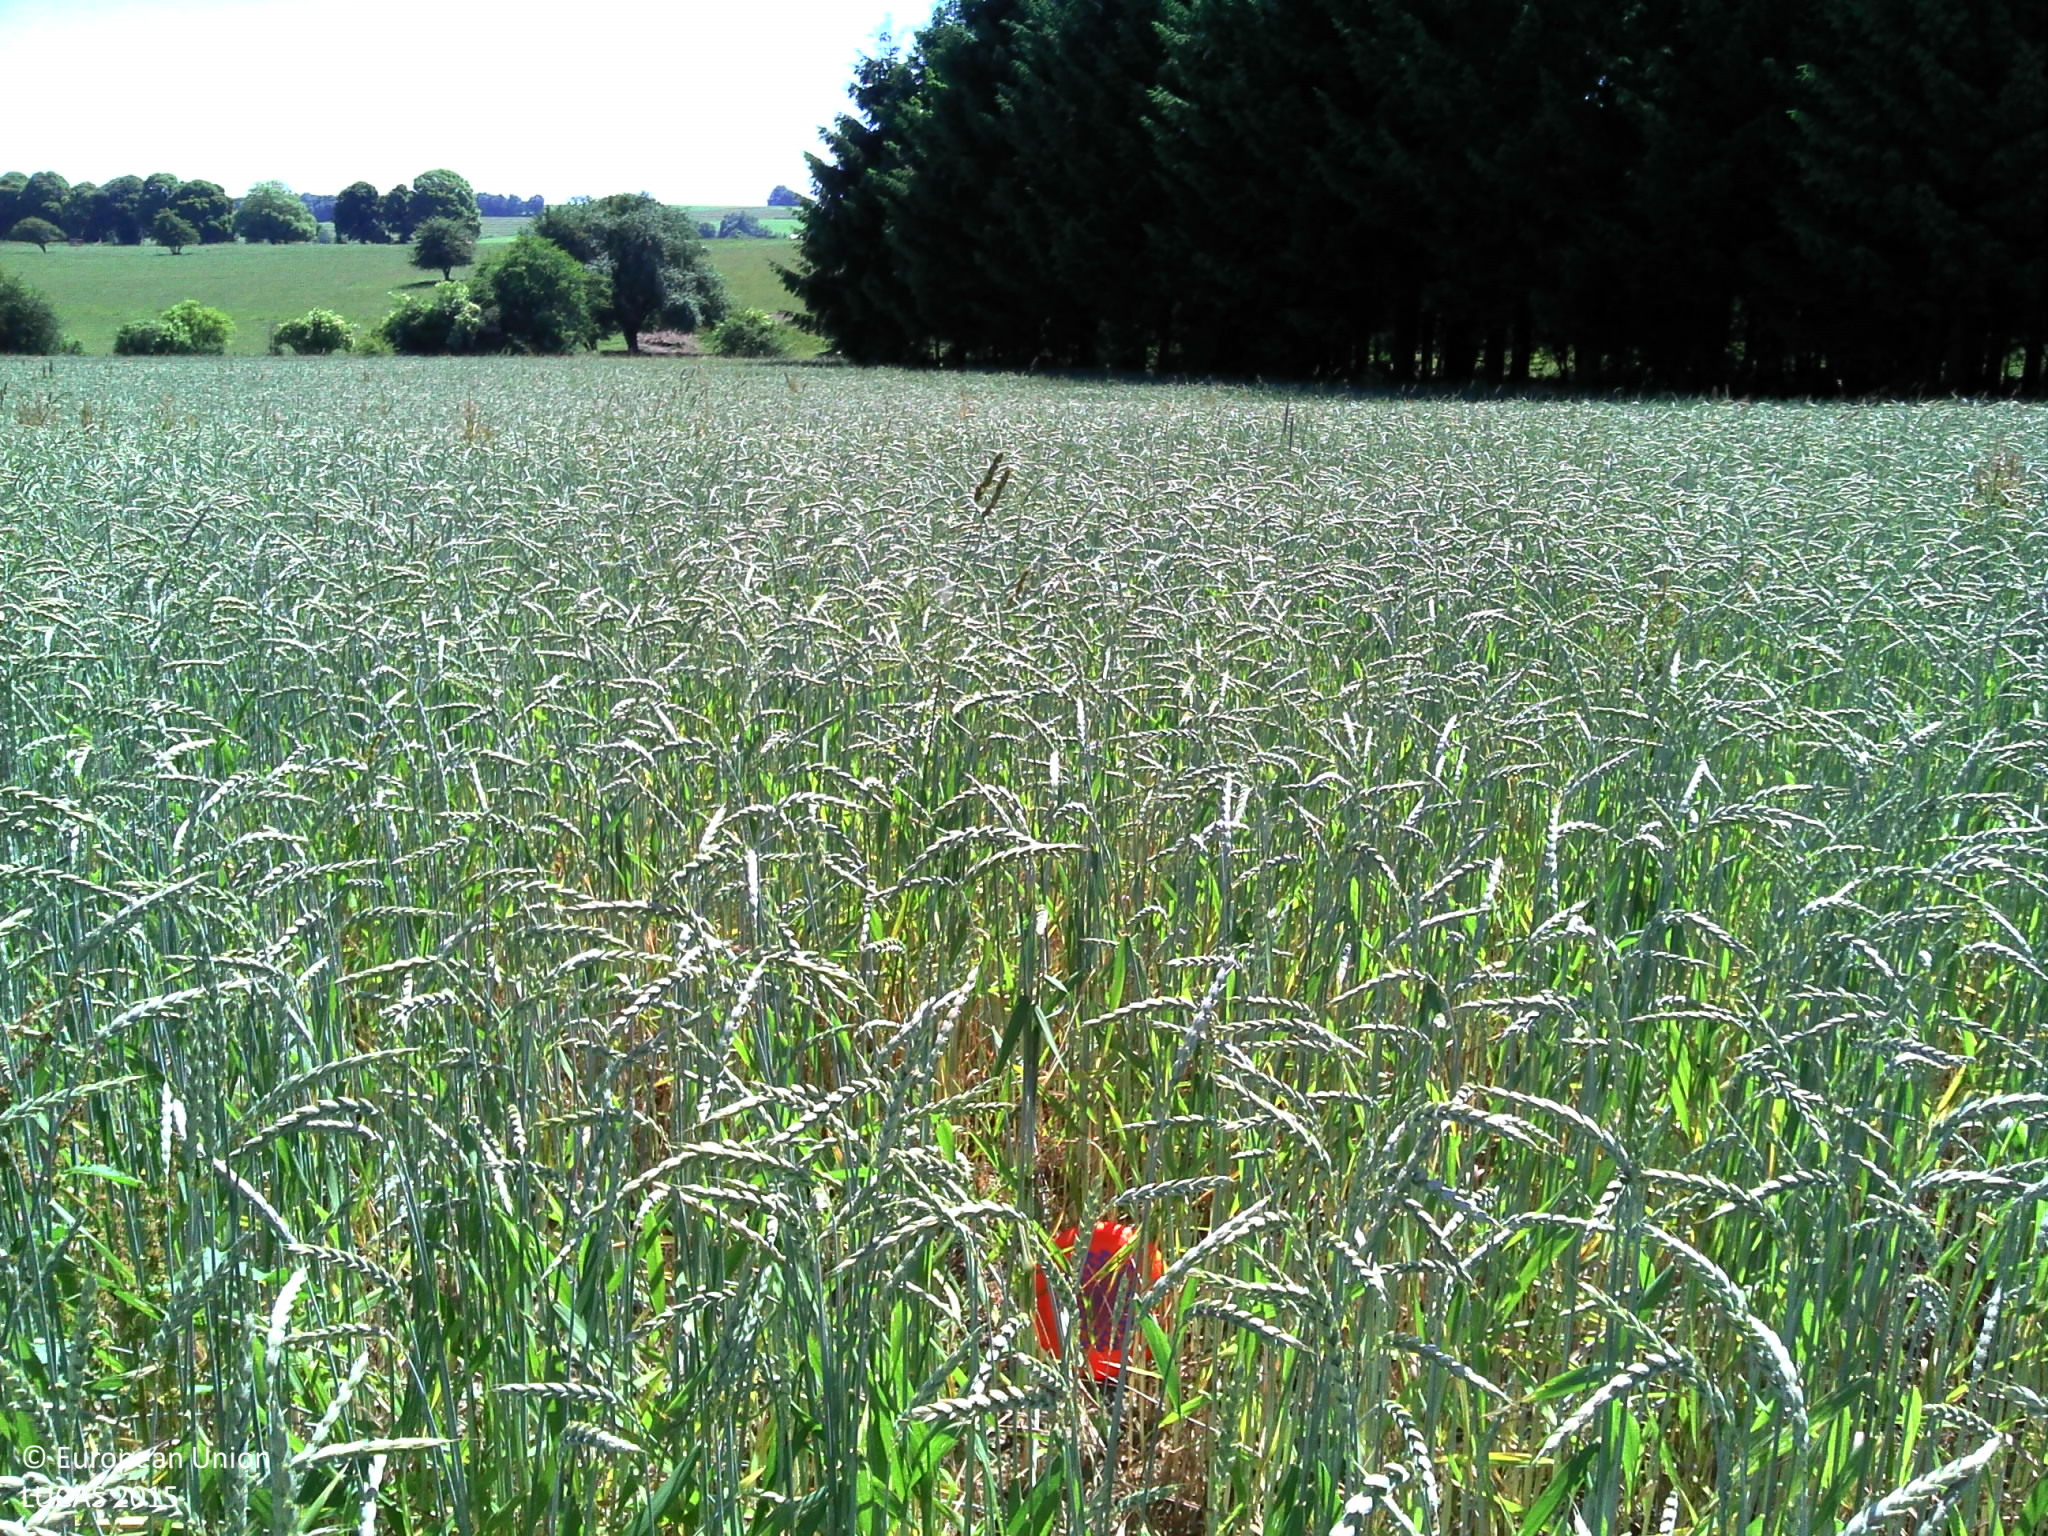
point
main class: Cropland
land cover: Common wheat
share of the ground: > 75 %
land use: Agriculture (excluding fallow land and kitchen gardens)
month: June
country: BE
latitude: 50.0062
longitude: 5.5195
